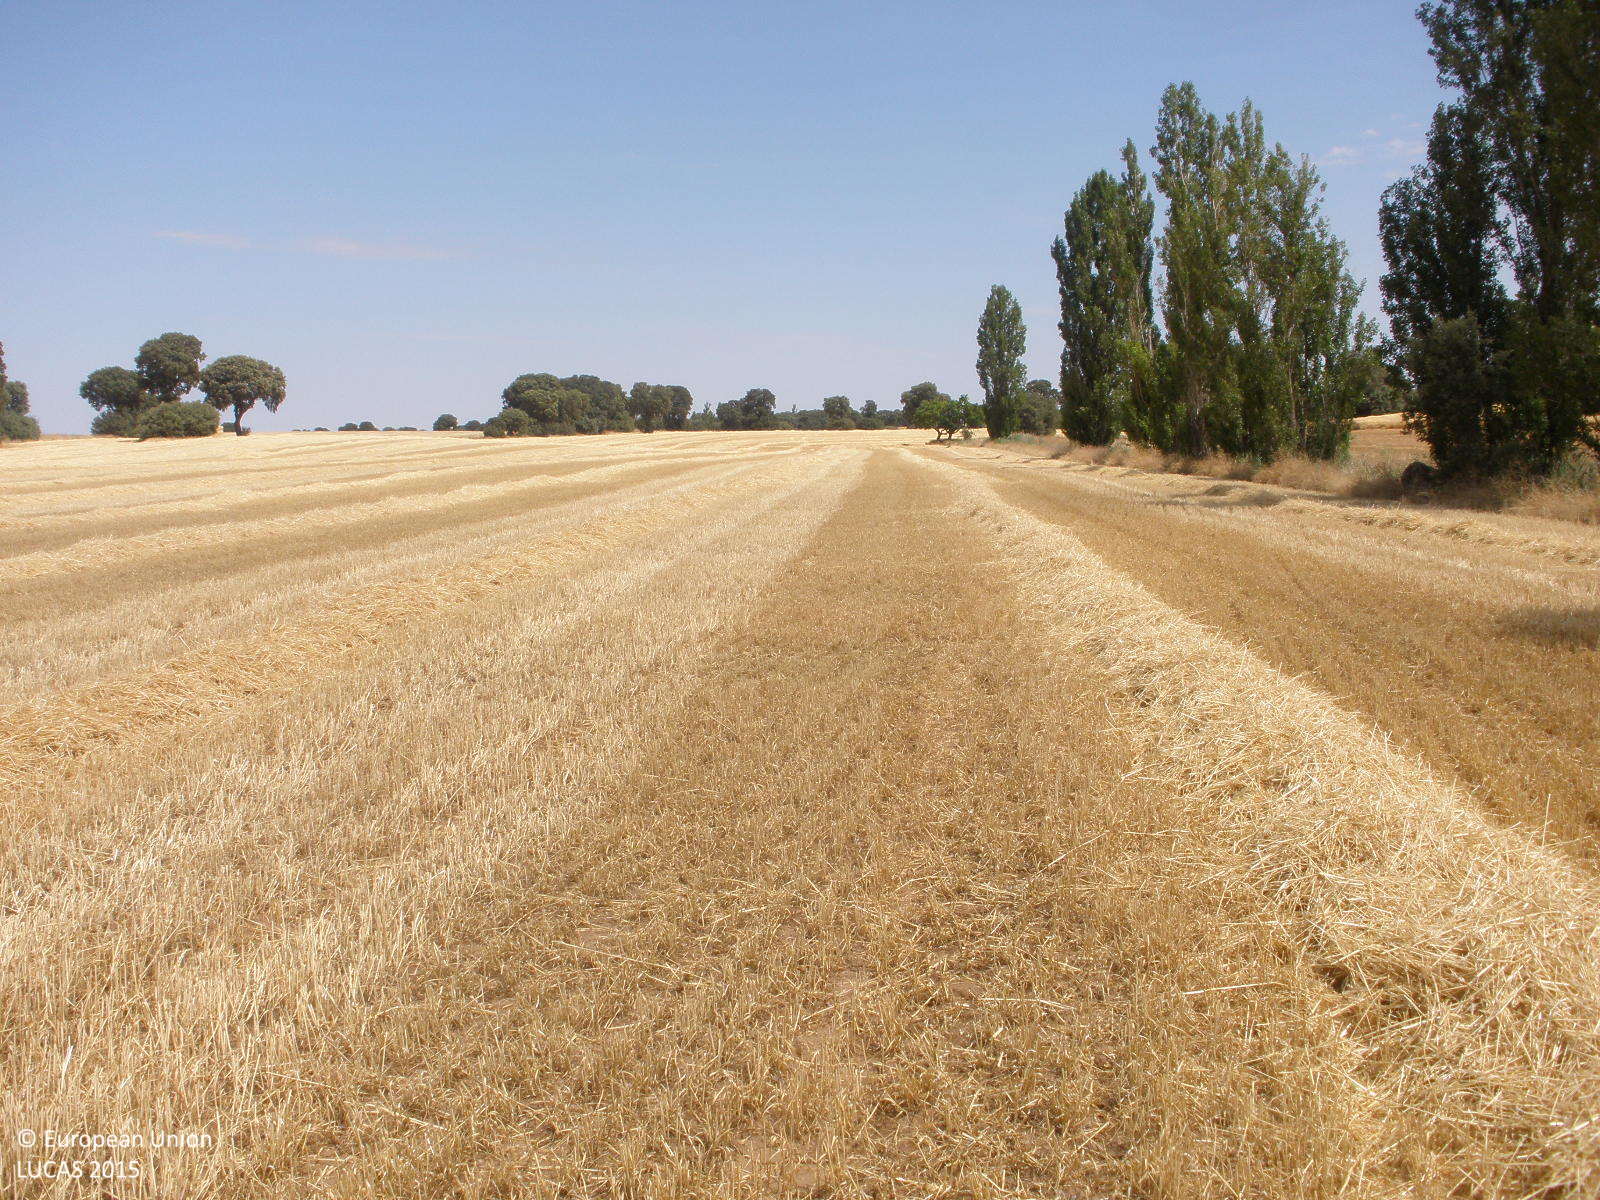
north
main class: Cropland
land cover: Common wheat
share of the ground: < 10 %
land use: Agriculture (excluding fallow land and kitchen gardens)
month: July
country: ES
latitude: 39.8896
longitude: -3.1568
